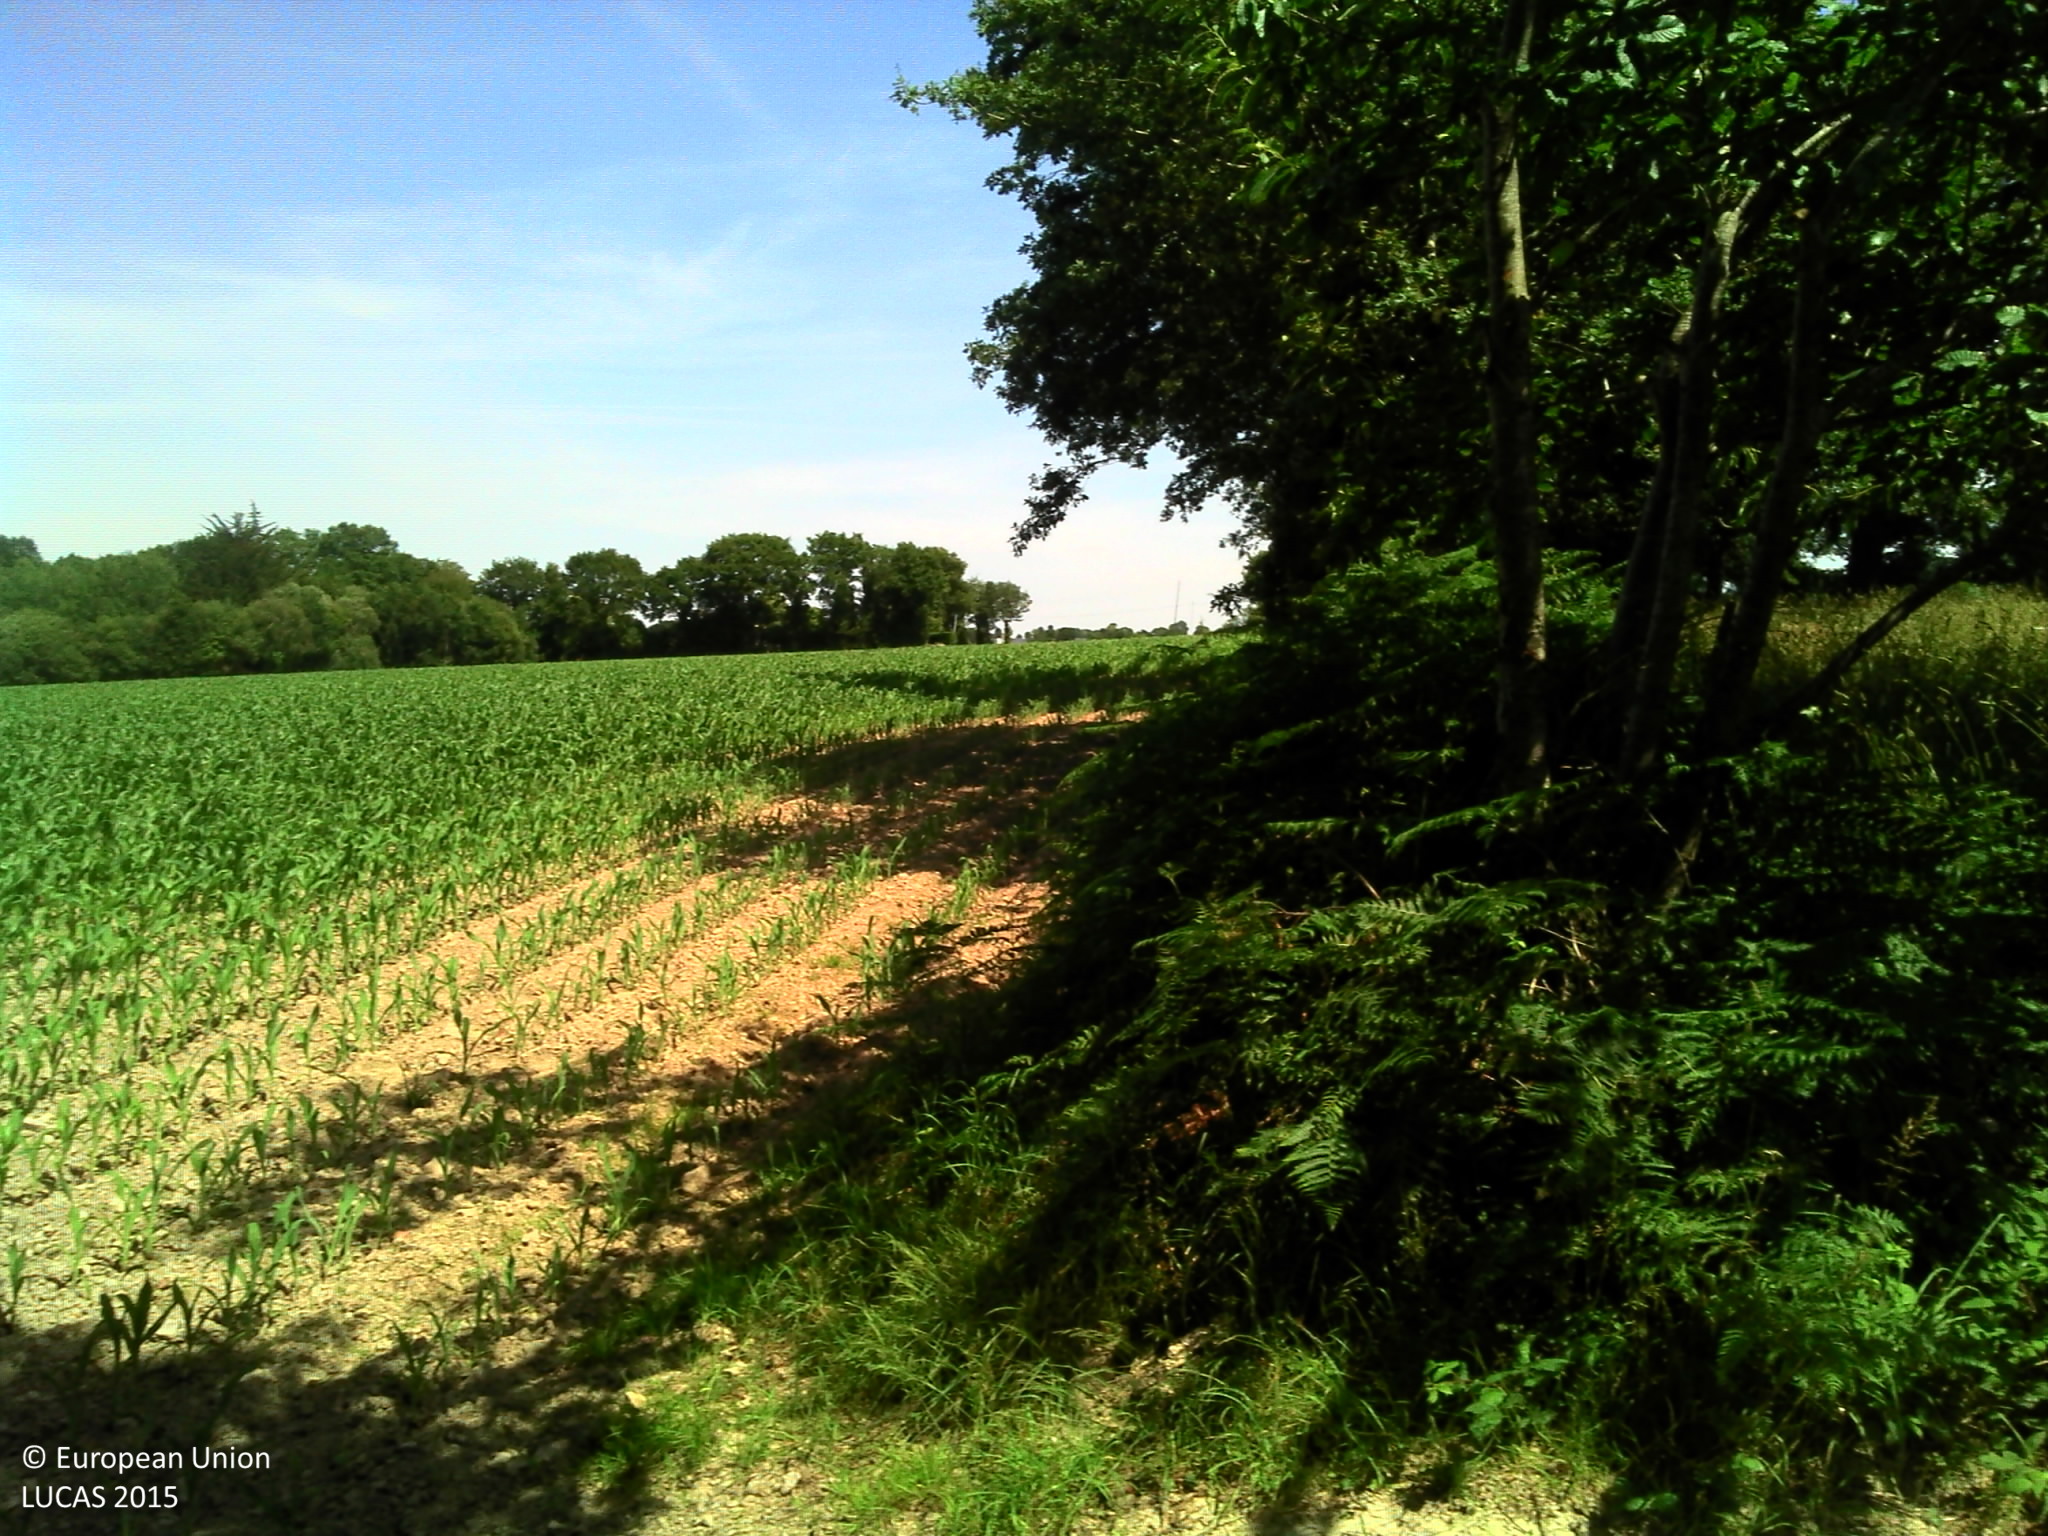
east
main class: Cropland
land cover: Maize
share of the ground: 25 - 50 %
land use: Agriculture (excluding fallow land and kitchen gardens)
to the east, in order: Abandoned hedges; Maize; Electric lines; Ditches and canals; Grass margins; Paved roads, cycling and walking lanes; Grass margins; Maize
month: June
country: FR
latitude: 48.0321
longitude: -2.0557
